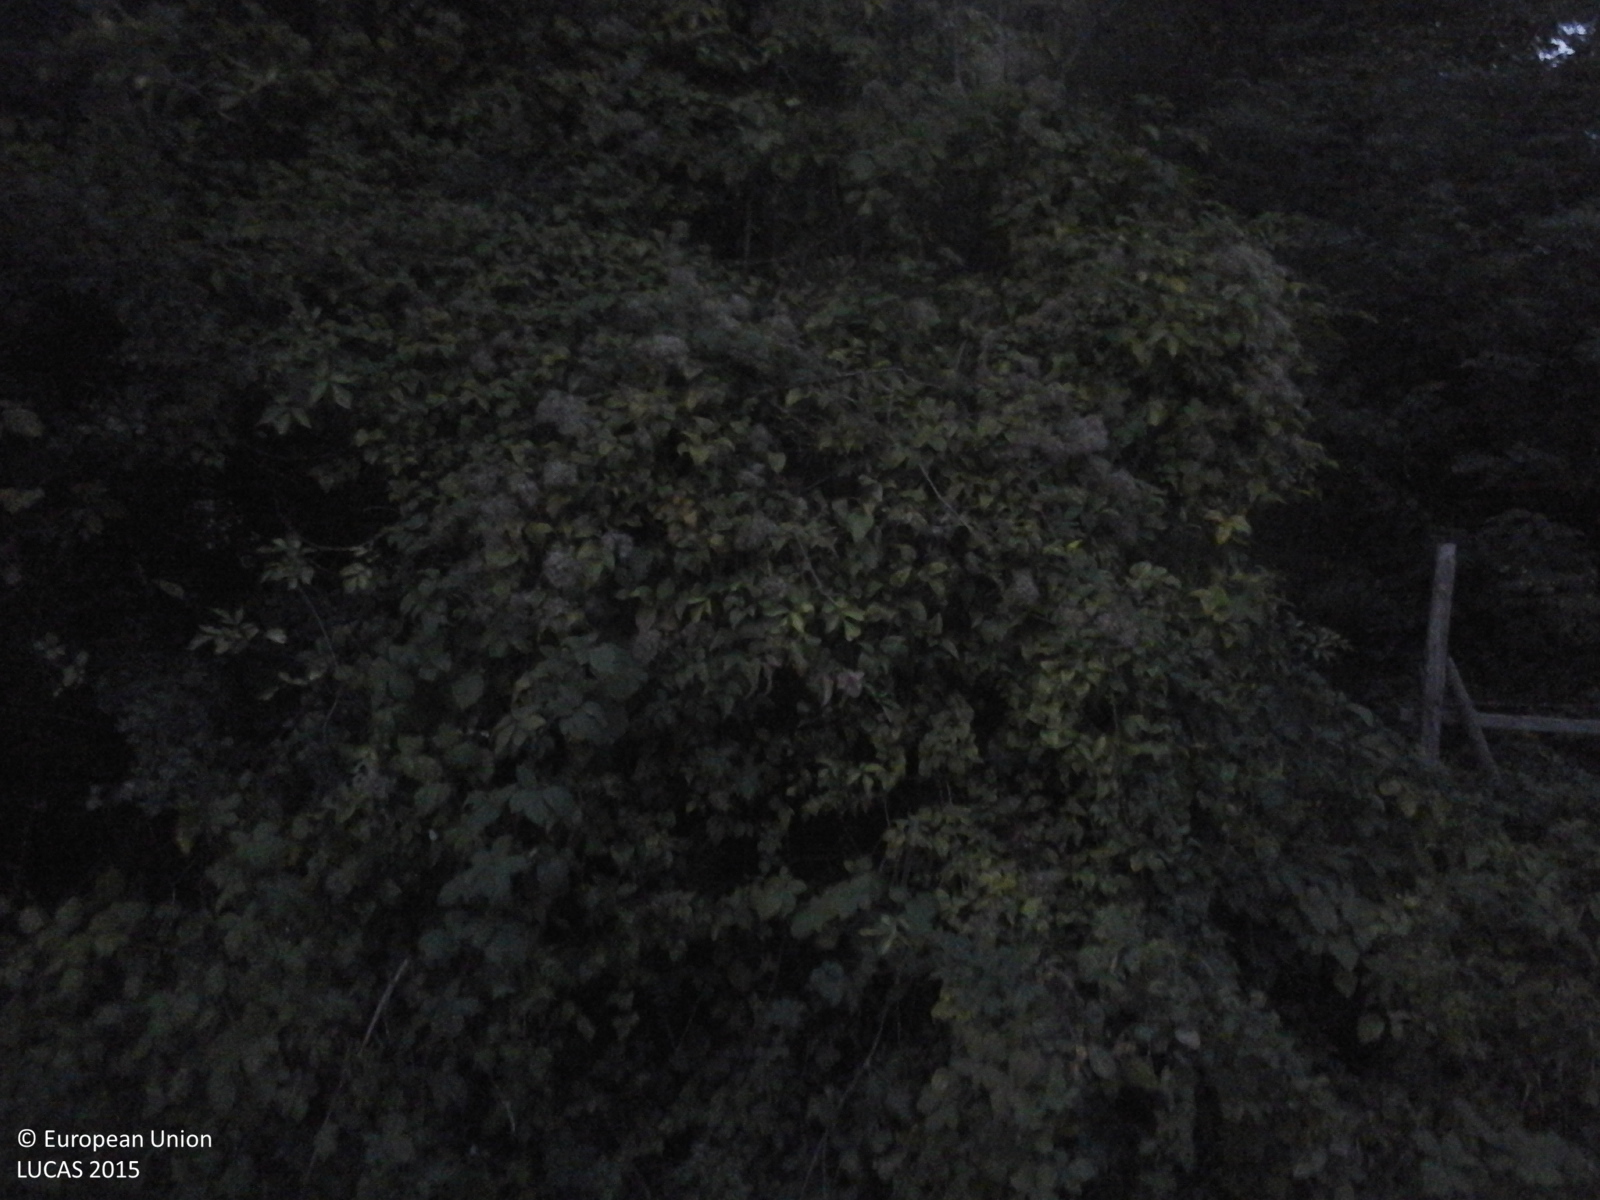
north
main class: Cropland
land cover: Apple fruit
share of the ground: 25 - 50 %
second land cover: Grassland without tree/shrub cover
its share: > 75 %
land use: Agriculture (excluding fallow land and kitchen gardens)
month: September
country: RO
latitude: 45.2336
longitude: 22.3332
